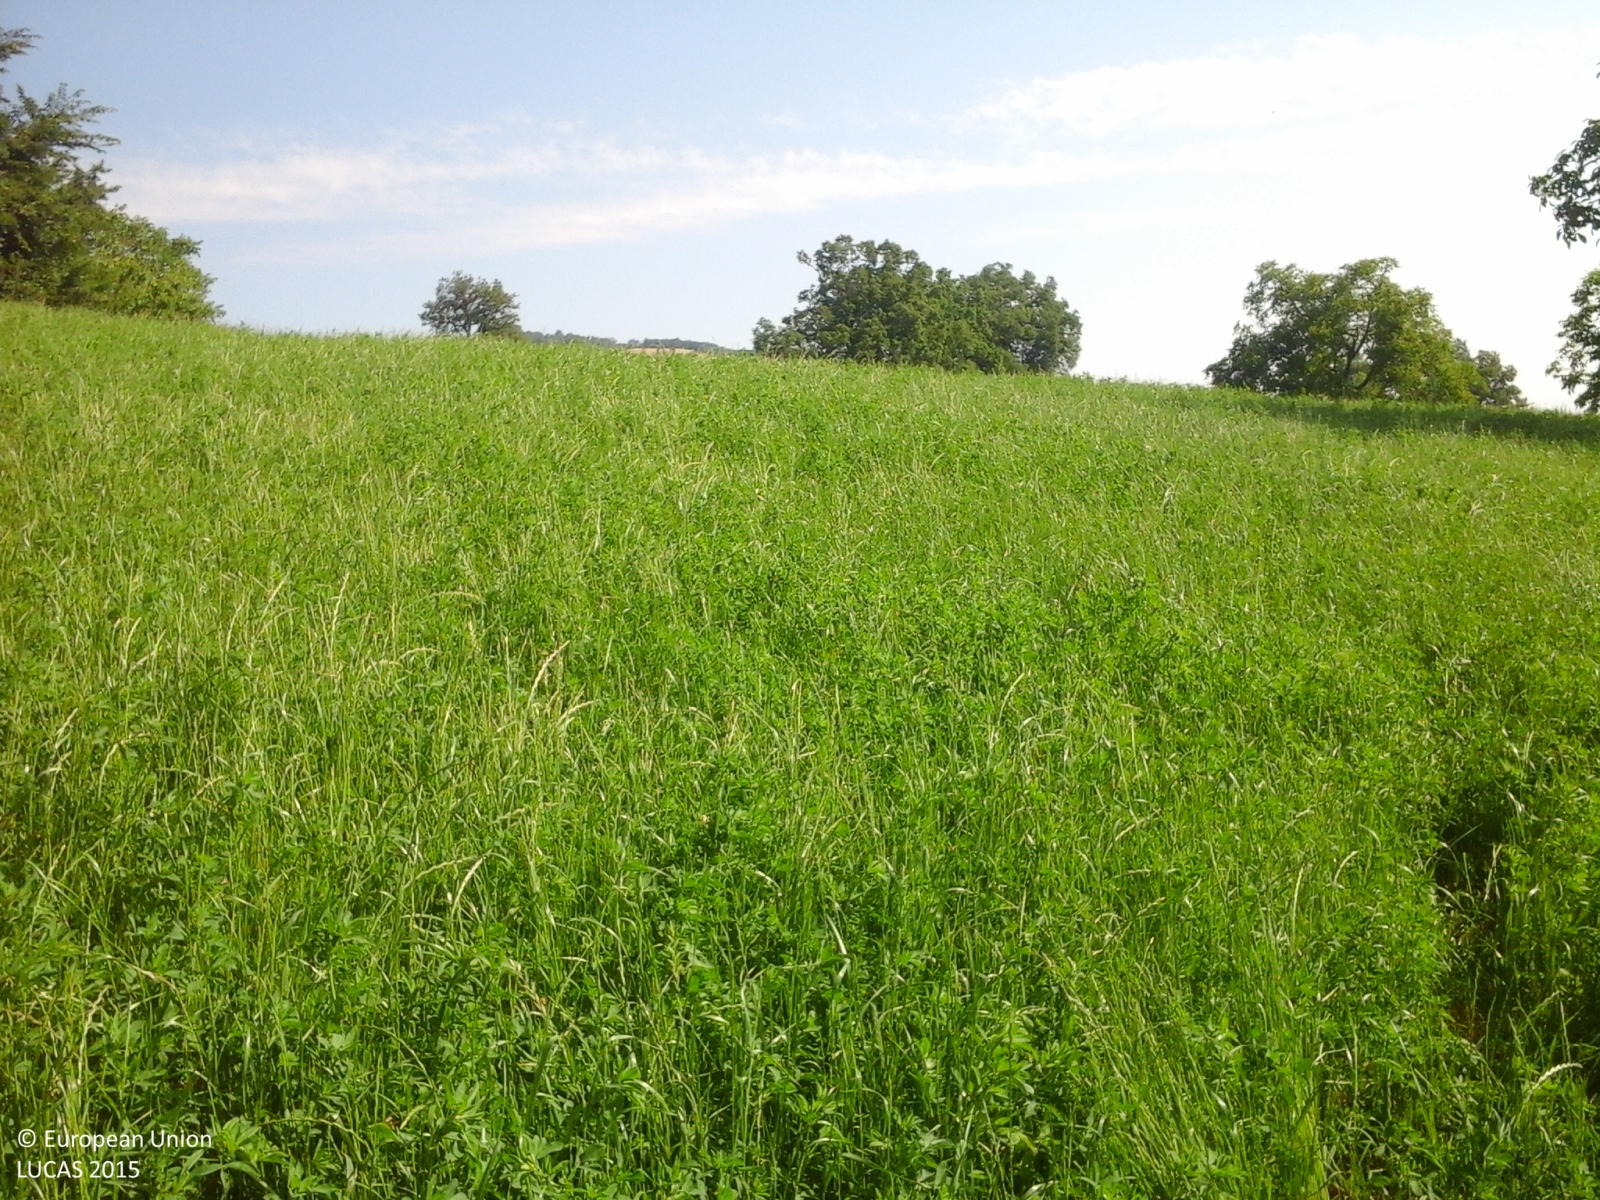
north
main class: Cropland
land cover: Lucerne
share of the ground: > 75 %
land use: Agriculture (excluding fallow land and kitchen gardens)
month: June
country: IT
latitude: 44.4209
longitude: 10.6140
